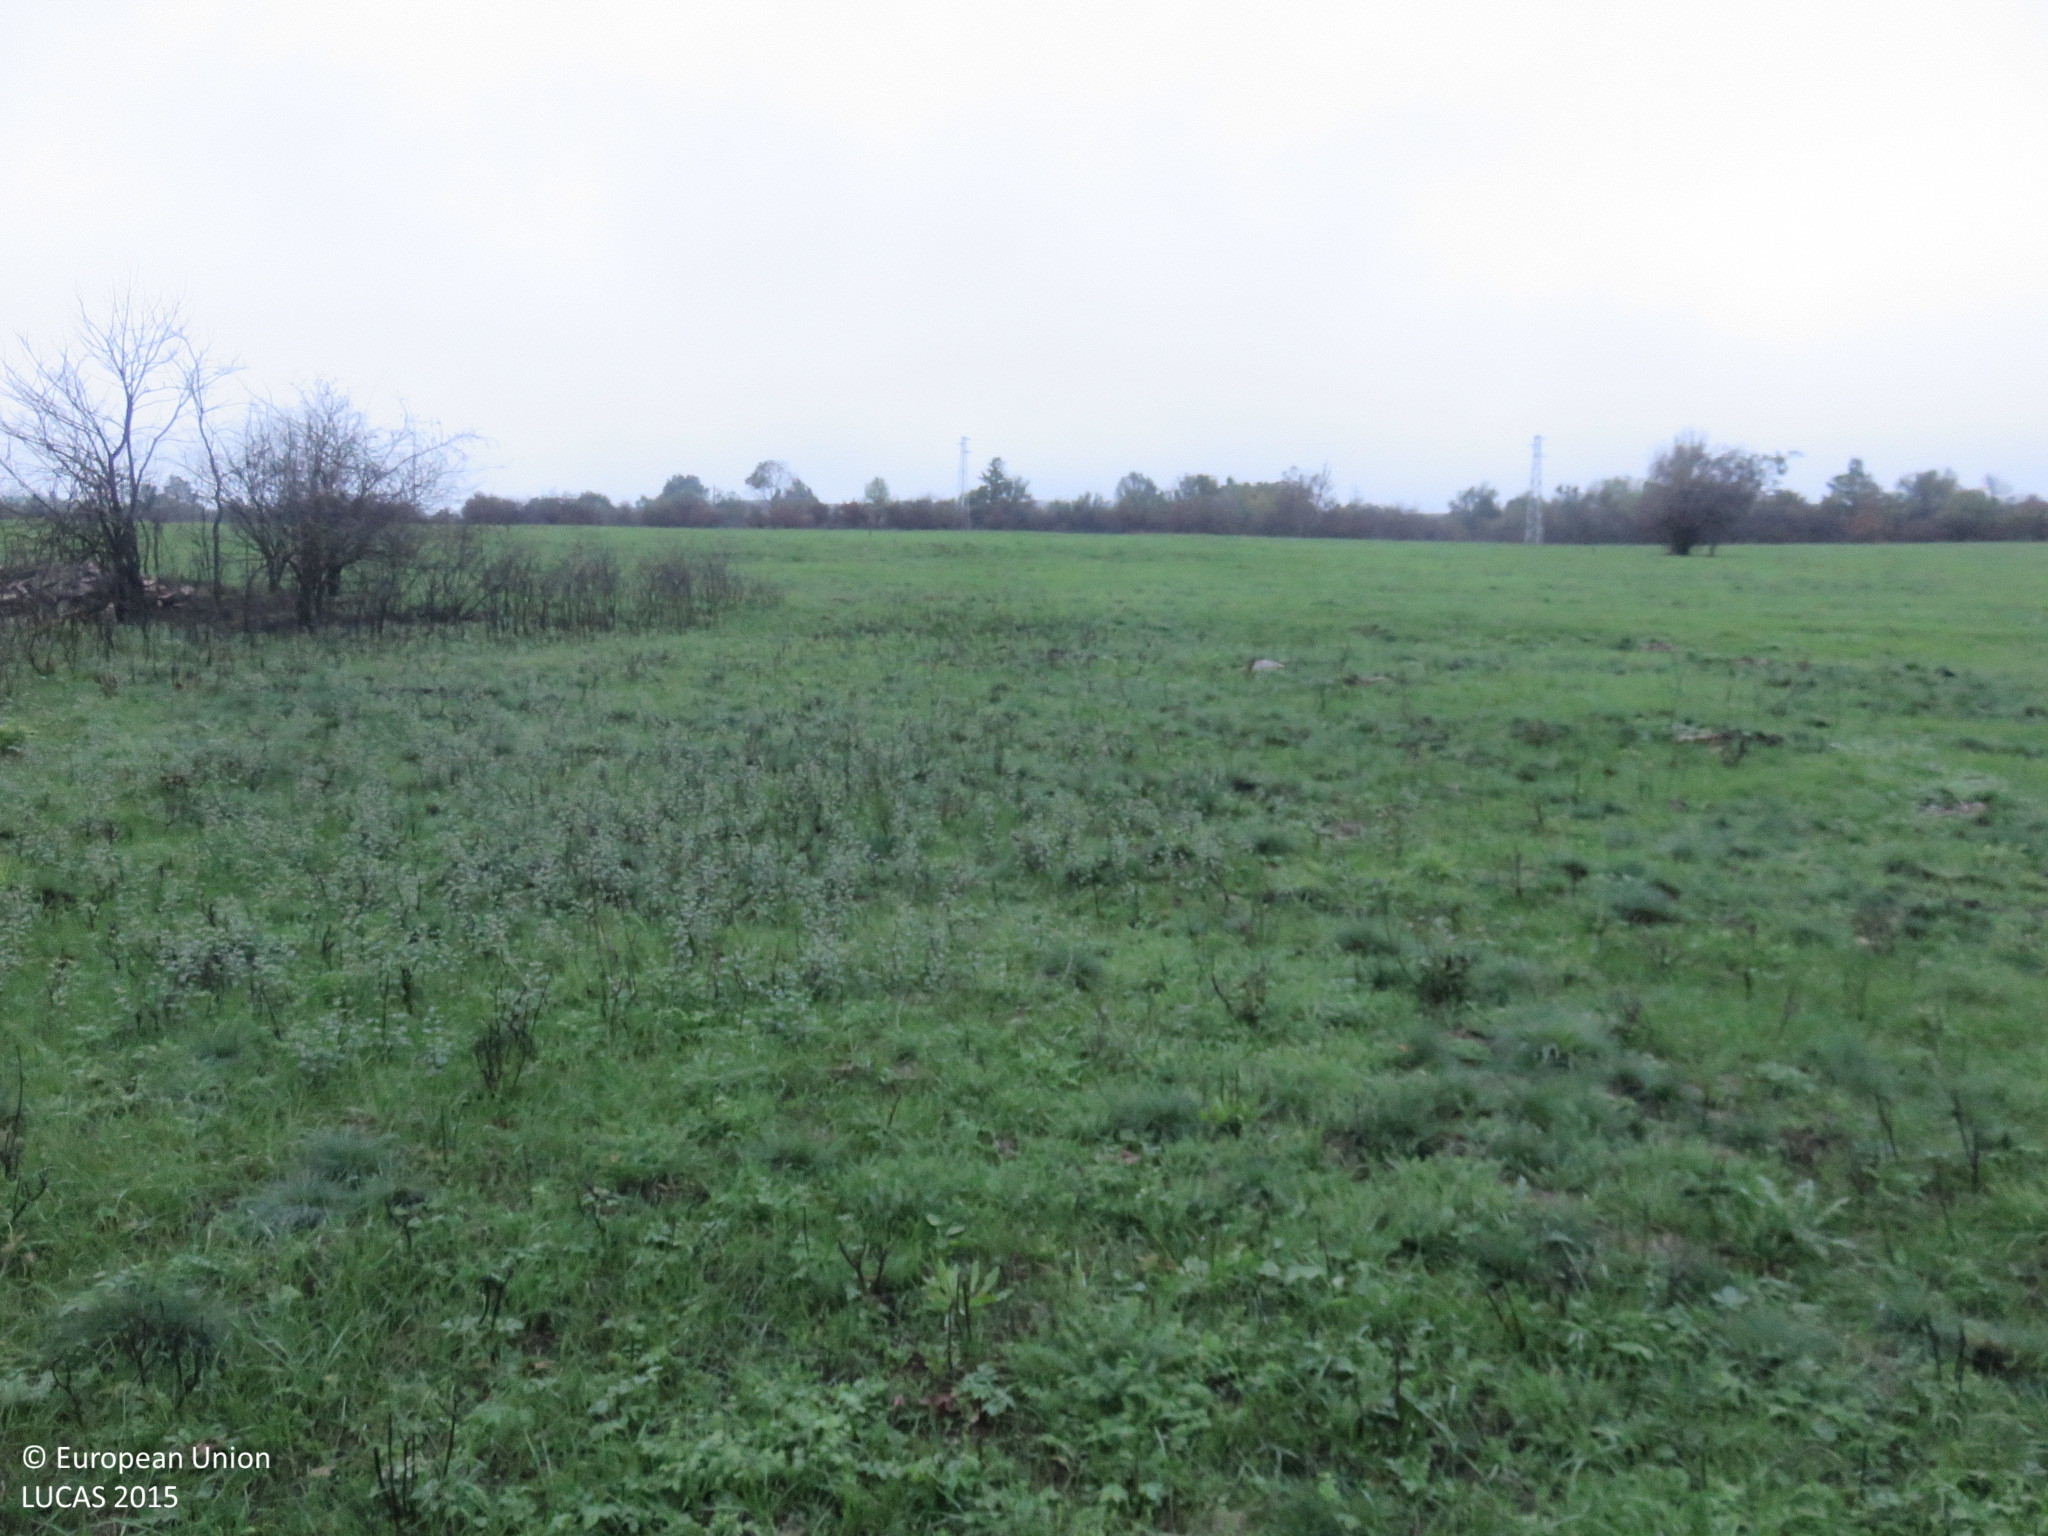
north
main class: Grassland
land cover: Grassland without tree/shrub cover
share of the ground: > 75 %
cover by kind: herbaceous plants 100 %
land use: Agriculture (excluding fallow land and kitchen gardens)
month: October
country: BG
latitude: 42.9539
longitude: 25.2826
